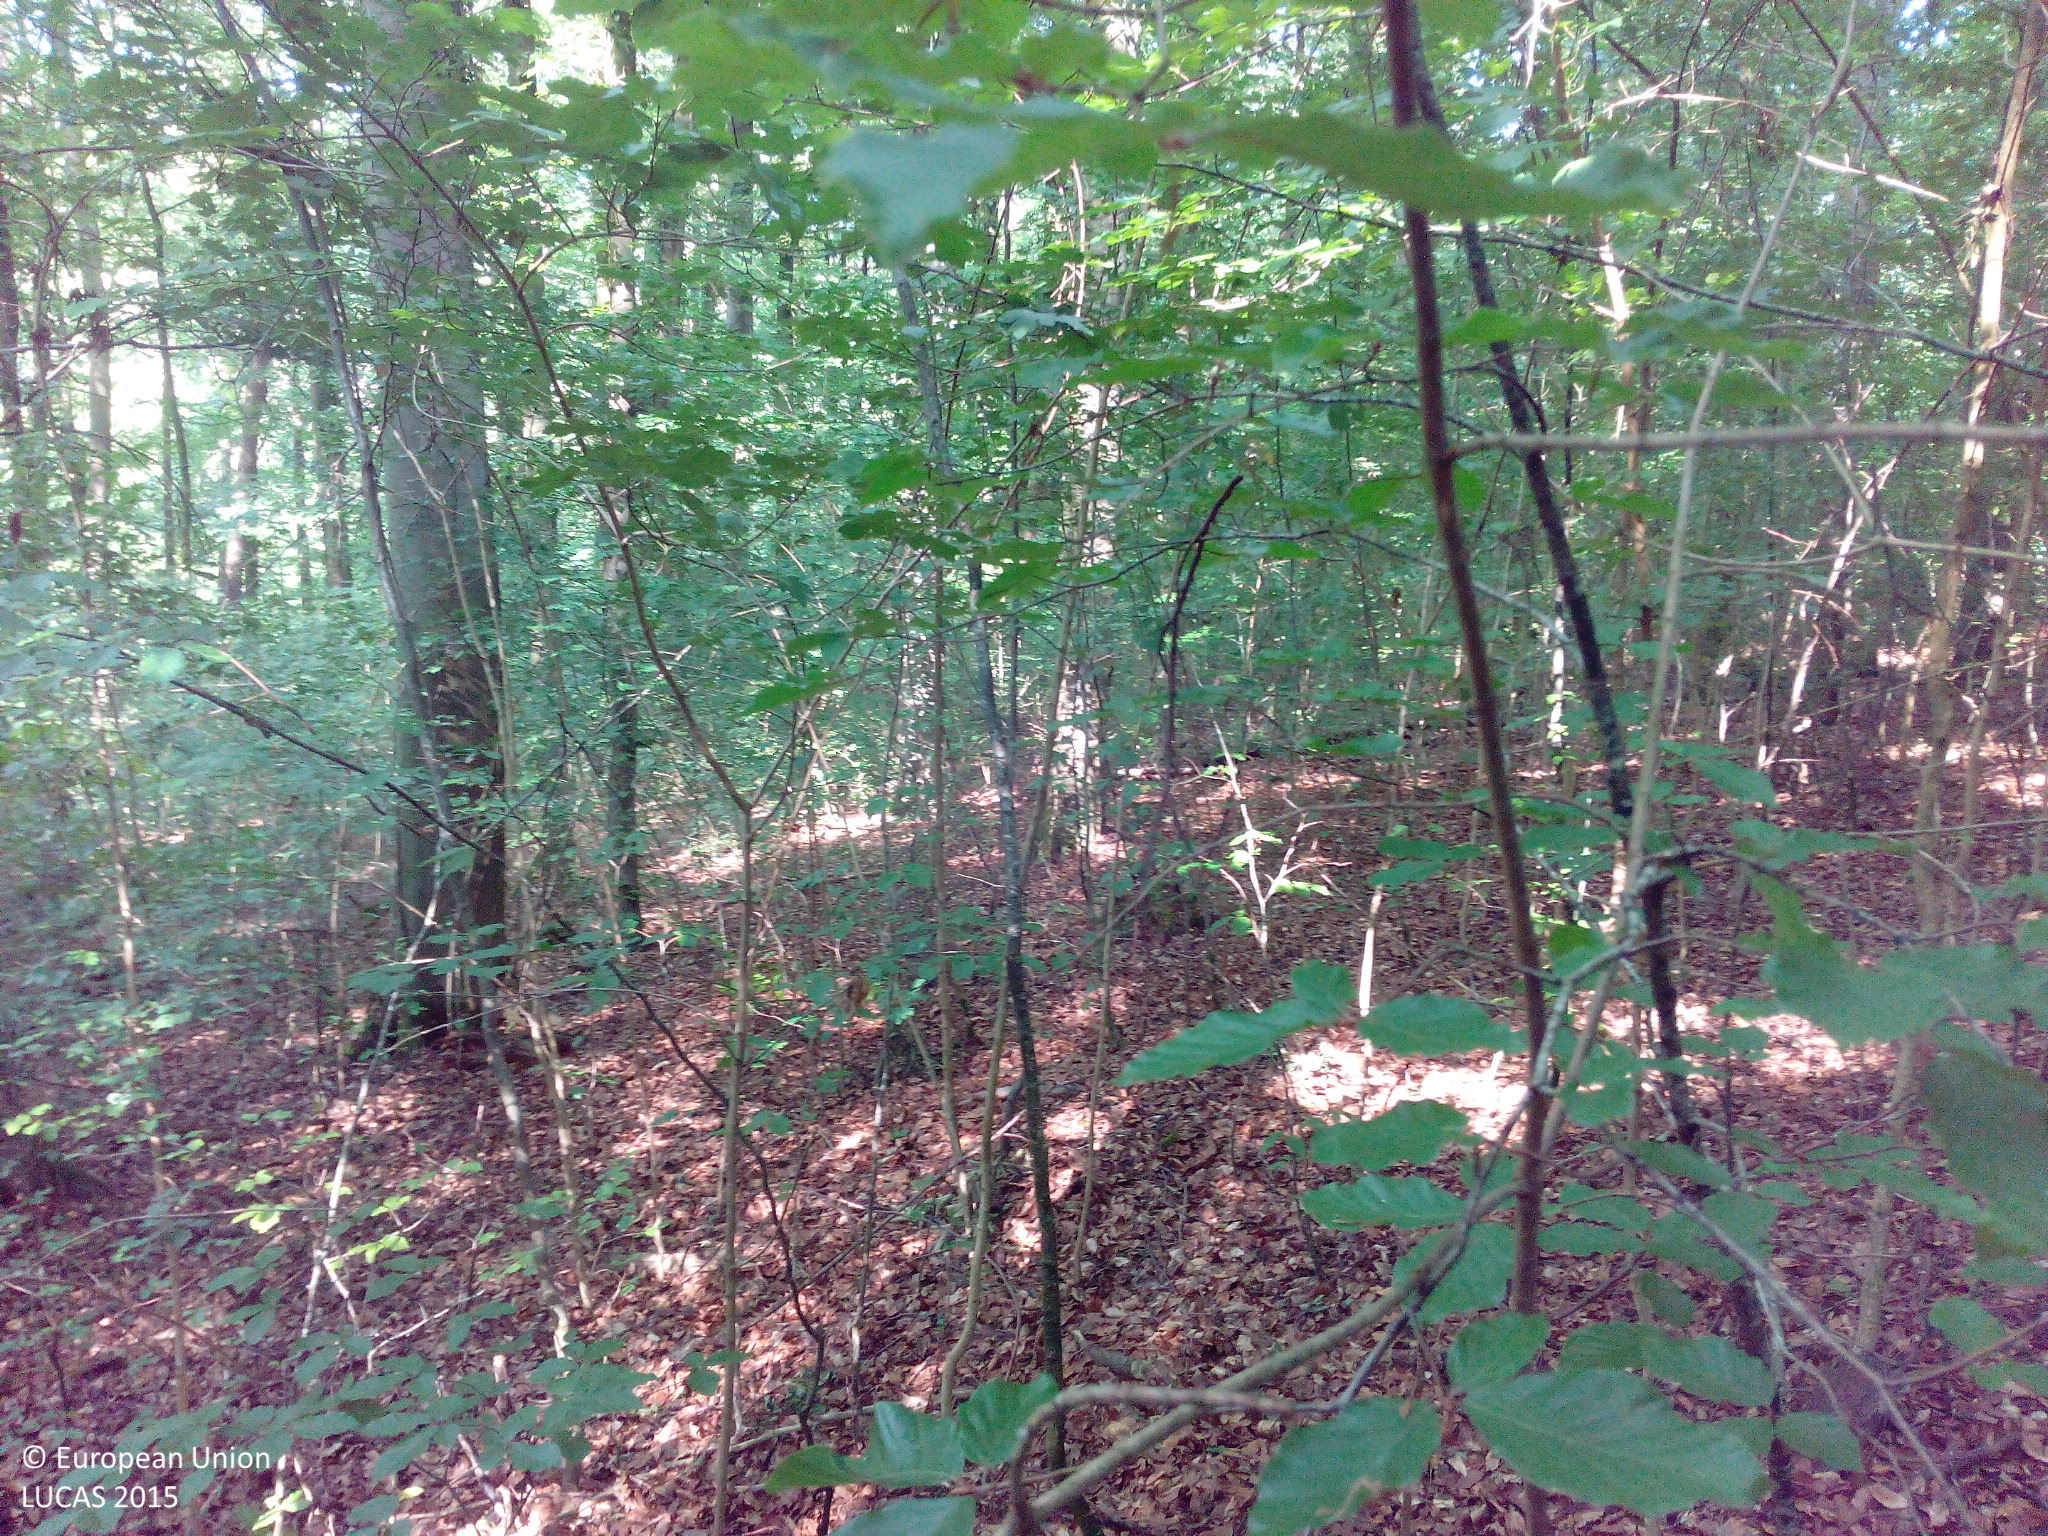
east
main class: Woodland
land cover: Broadleaved woodland
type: mesophytic deciduous forest
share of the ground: > 75 %
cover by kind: broadleaved forest trees 100 %
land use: Forestry
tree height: > 5 m
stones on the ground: < 10 %
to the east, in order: Broadleaved woodland; Tracks; Broadleaved woodland; Tracks; Broadleaved woodland; Tracks
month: July
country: DE
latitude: 49.7706
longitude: 9.9028
